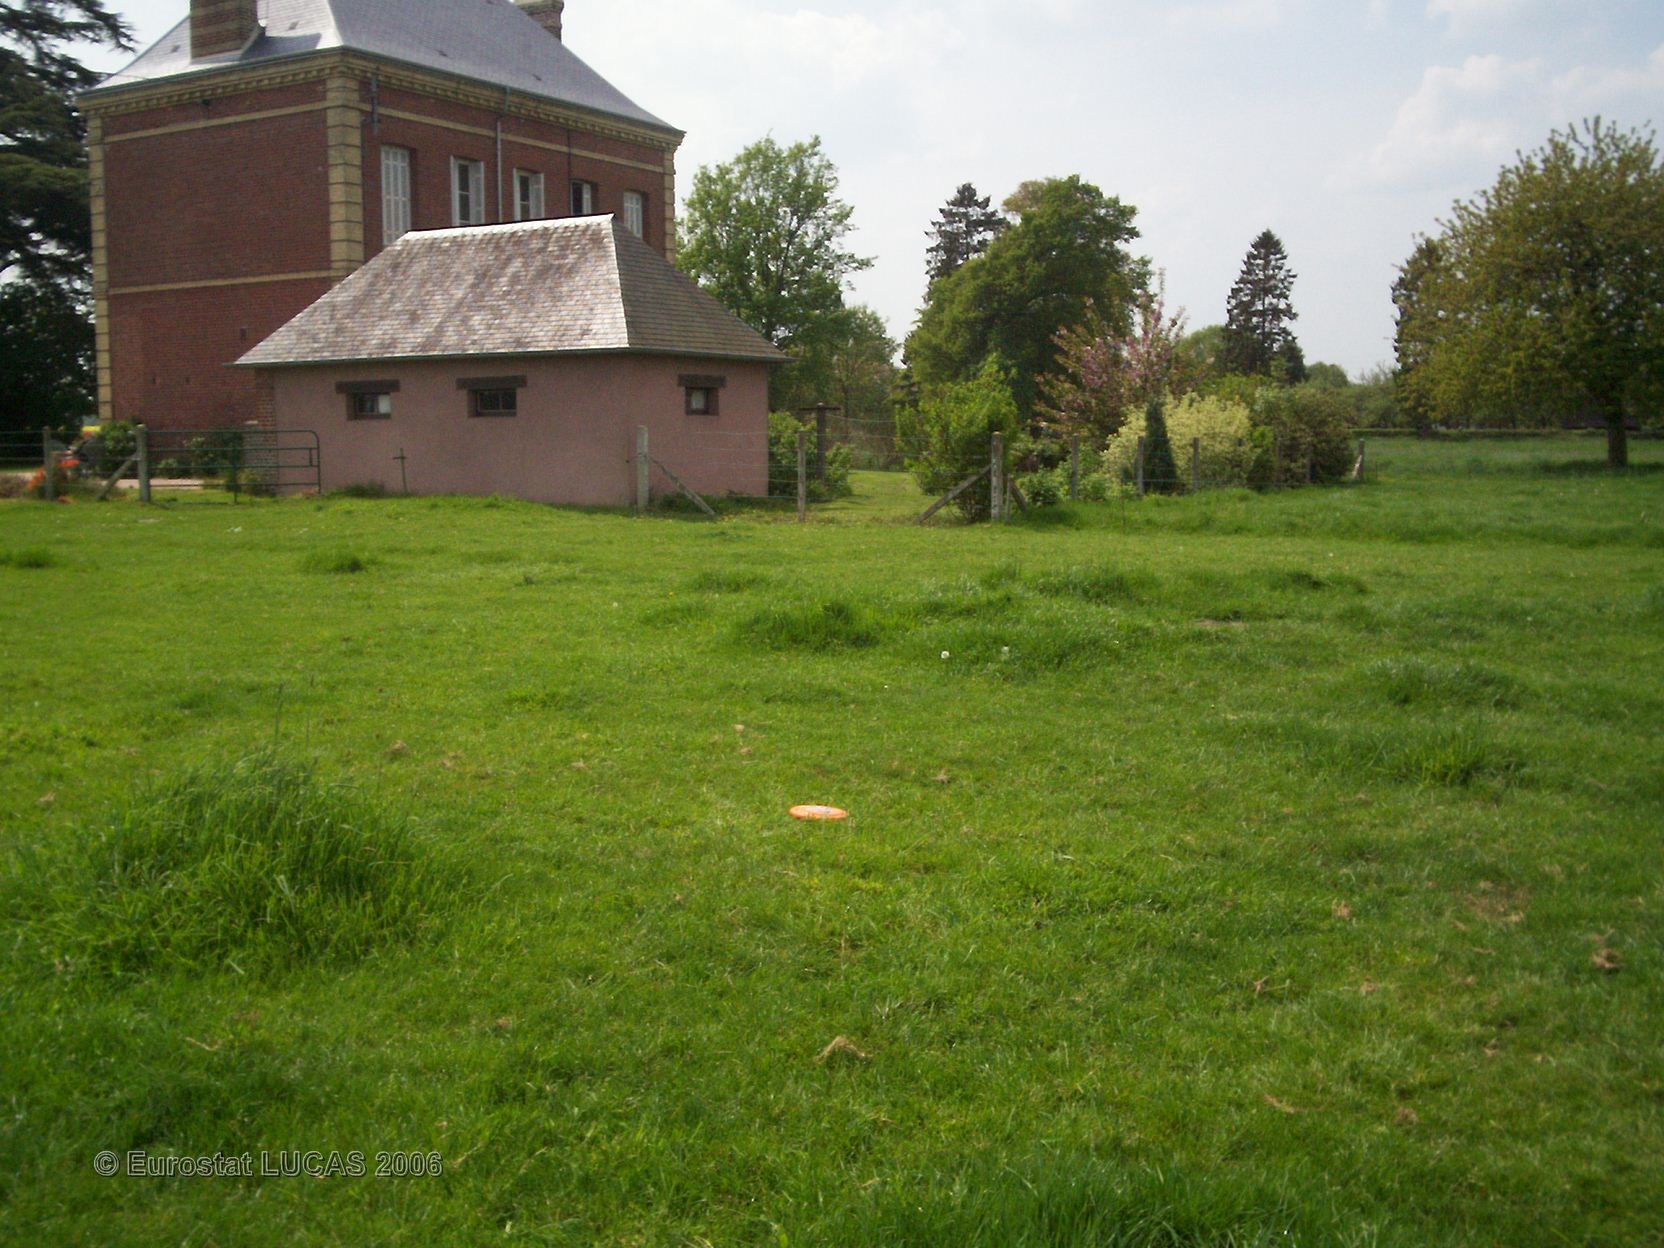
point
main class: Grassland
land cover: Grassland without tree/shrub cover
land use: Agriculture (excluding fallow land and kitchen gardens)
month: May
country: FR
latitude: 49.2822
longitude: 0.5298
